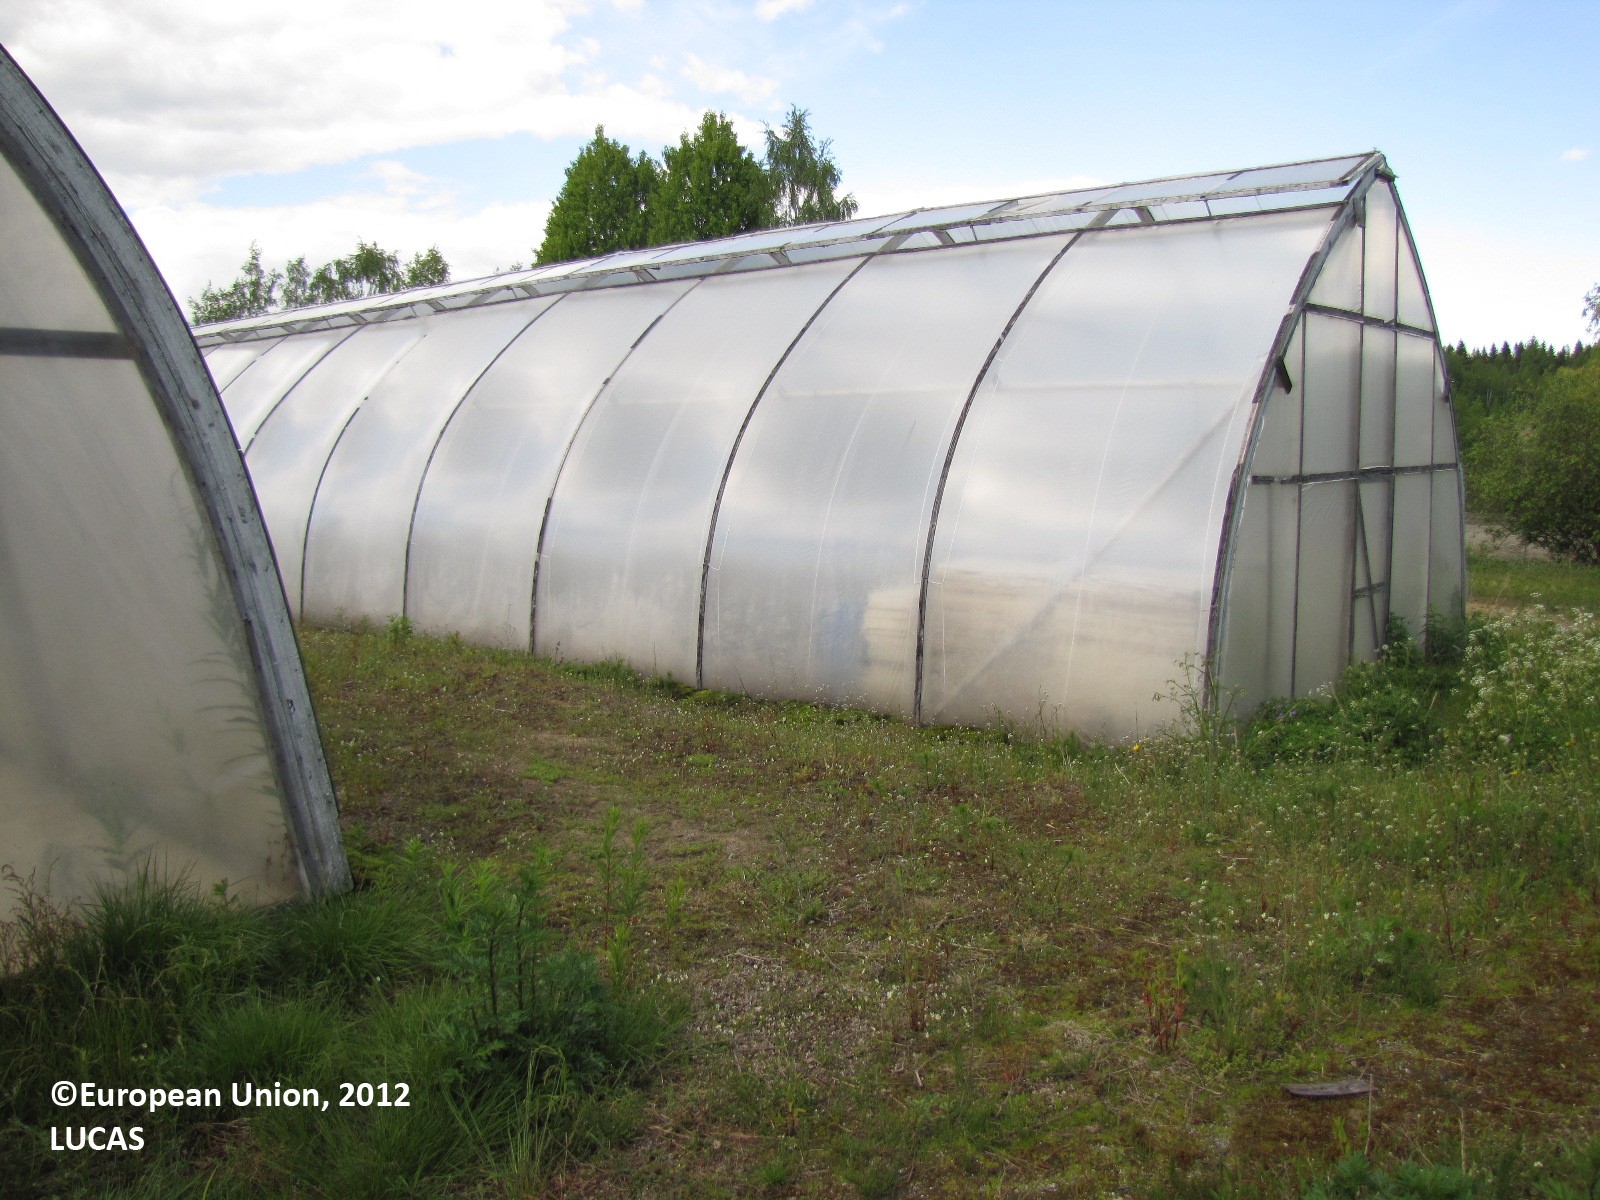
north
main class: Artificial land
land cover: Greenhouses
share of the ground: 25 - 50 %
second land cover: Floriculture and ornamental plants
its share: 25 - 50 %
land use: Agriculture (excluding fallow land and kitchen gardens)
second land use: Fallow land
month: June
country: FI
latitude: 61.2834
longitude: 22.9263
